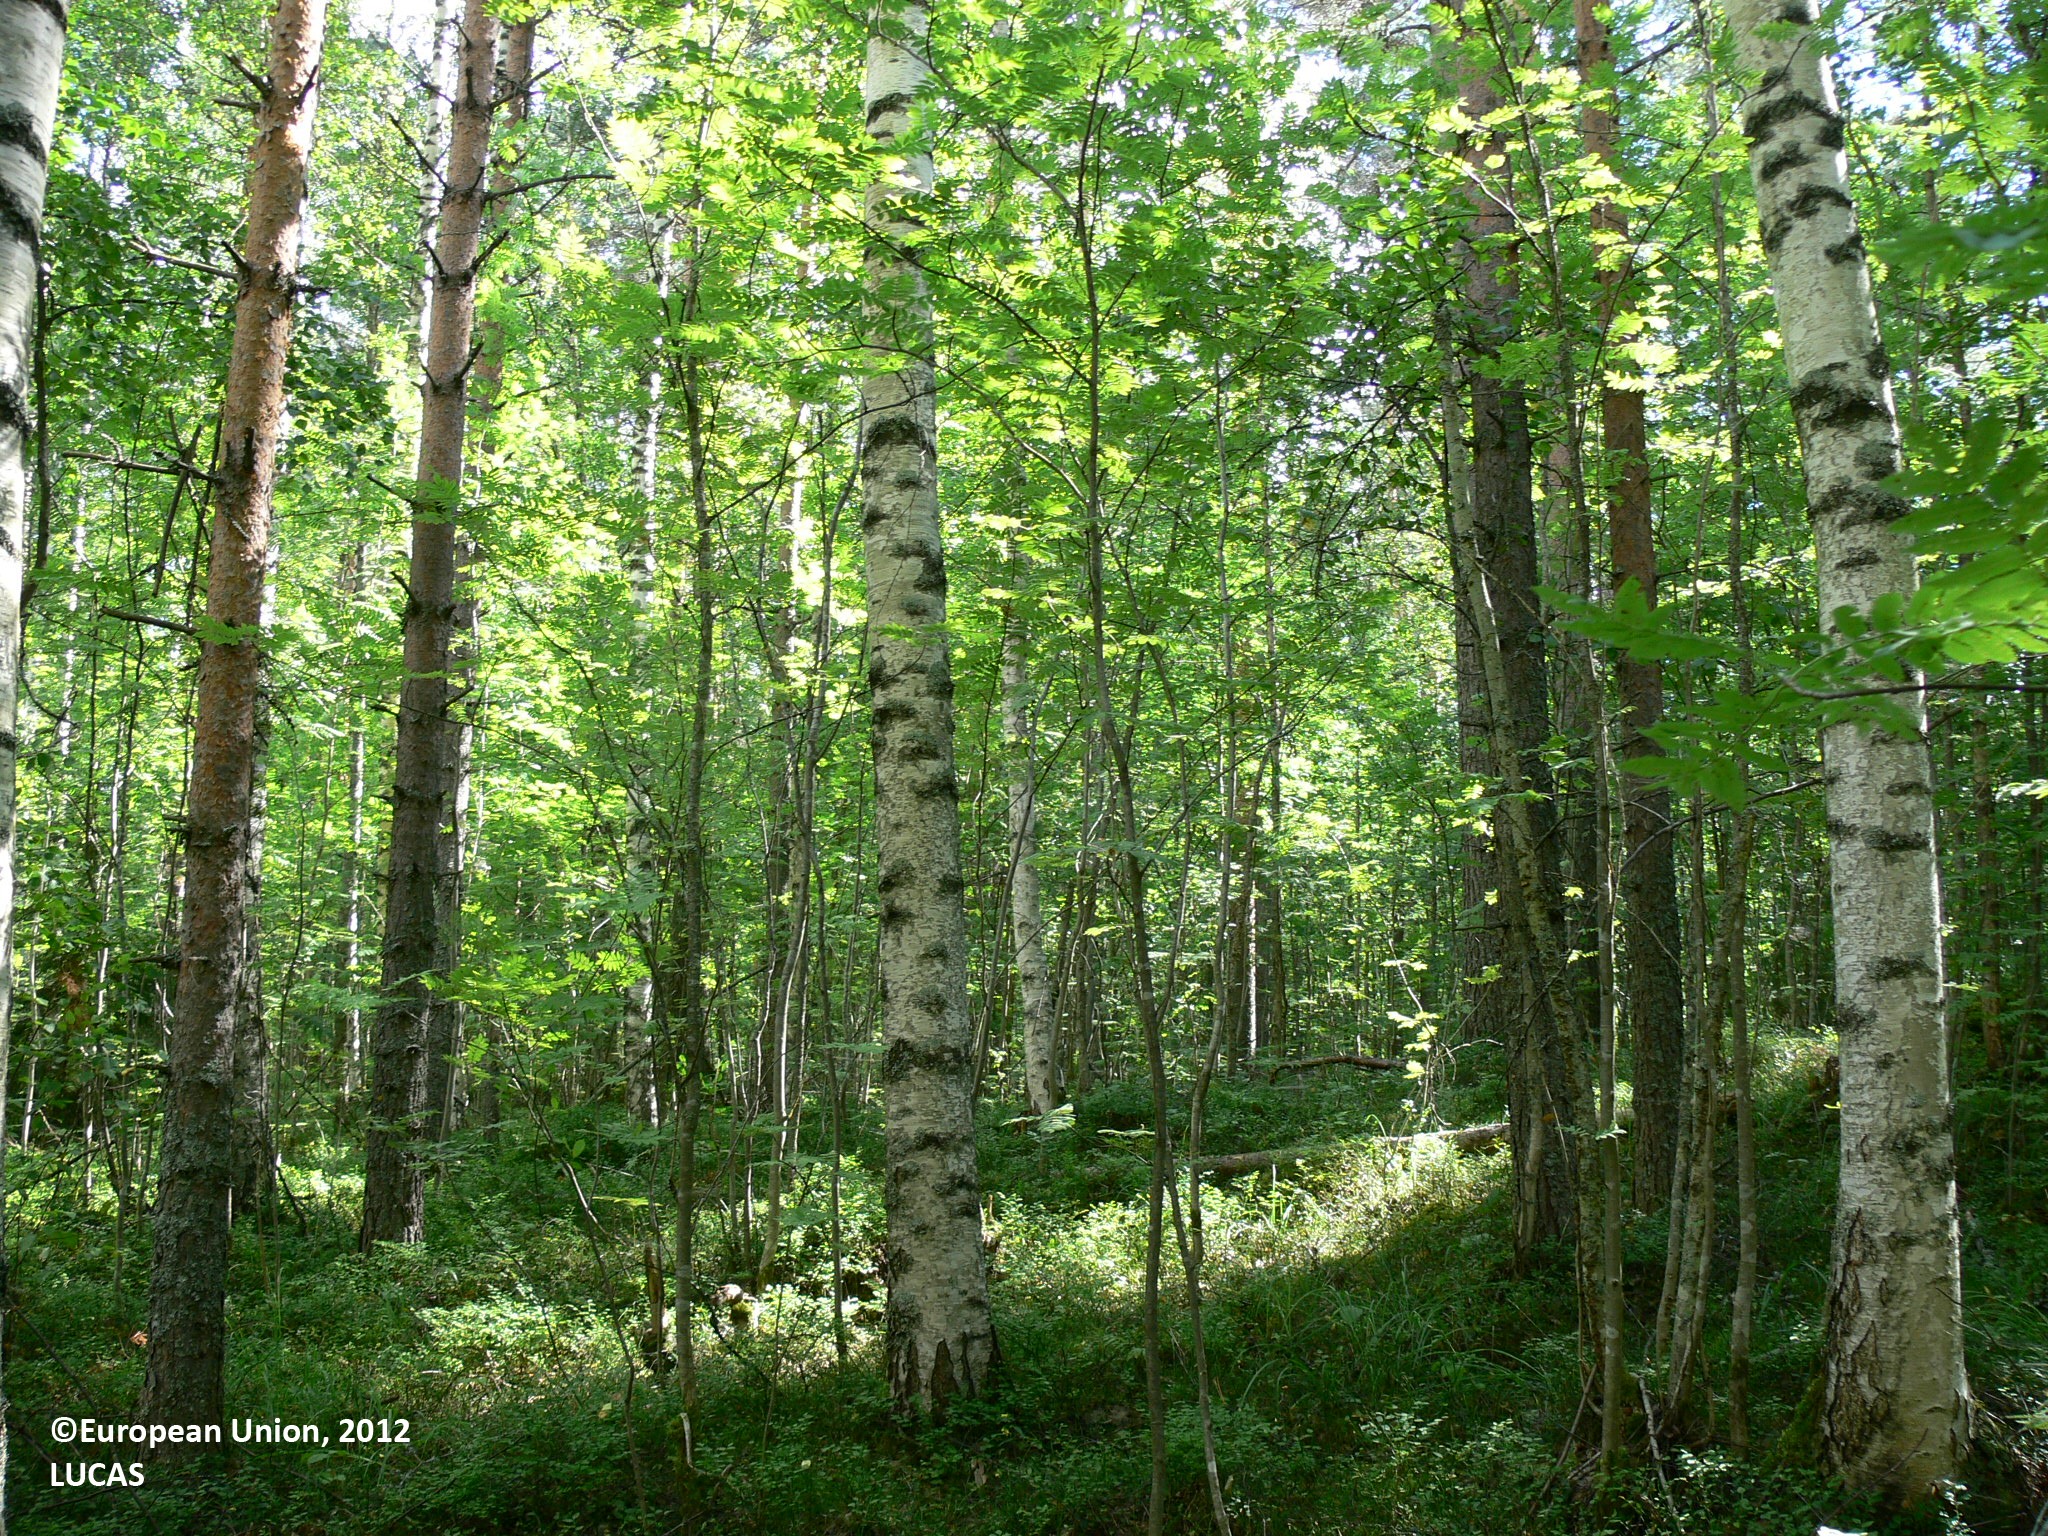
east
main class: Woodland
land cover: Pine dominated mixed woodland
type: boreal forest
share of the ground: > 75 %
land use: Forestry
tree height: > 5 m
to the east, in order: Pine dominated mixed woodland; Ditches and canals; Pine dominated mixed woodland; Pine dominated coniferous woodland; Pine dominated mixed woodland; Pine dominated coniferous woodland; Grass margins; Paved roads, cycling and walking lanes; Grass margins; Pine dominated coniferous woodland
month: August
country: FI
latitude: 62.0494
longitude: 29.4636
